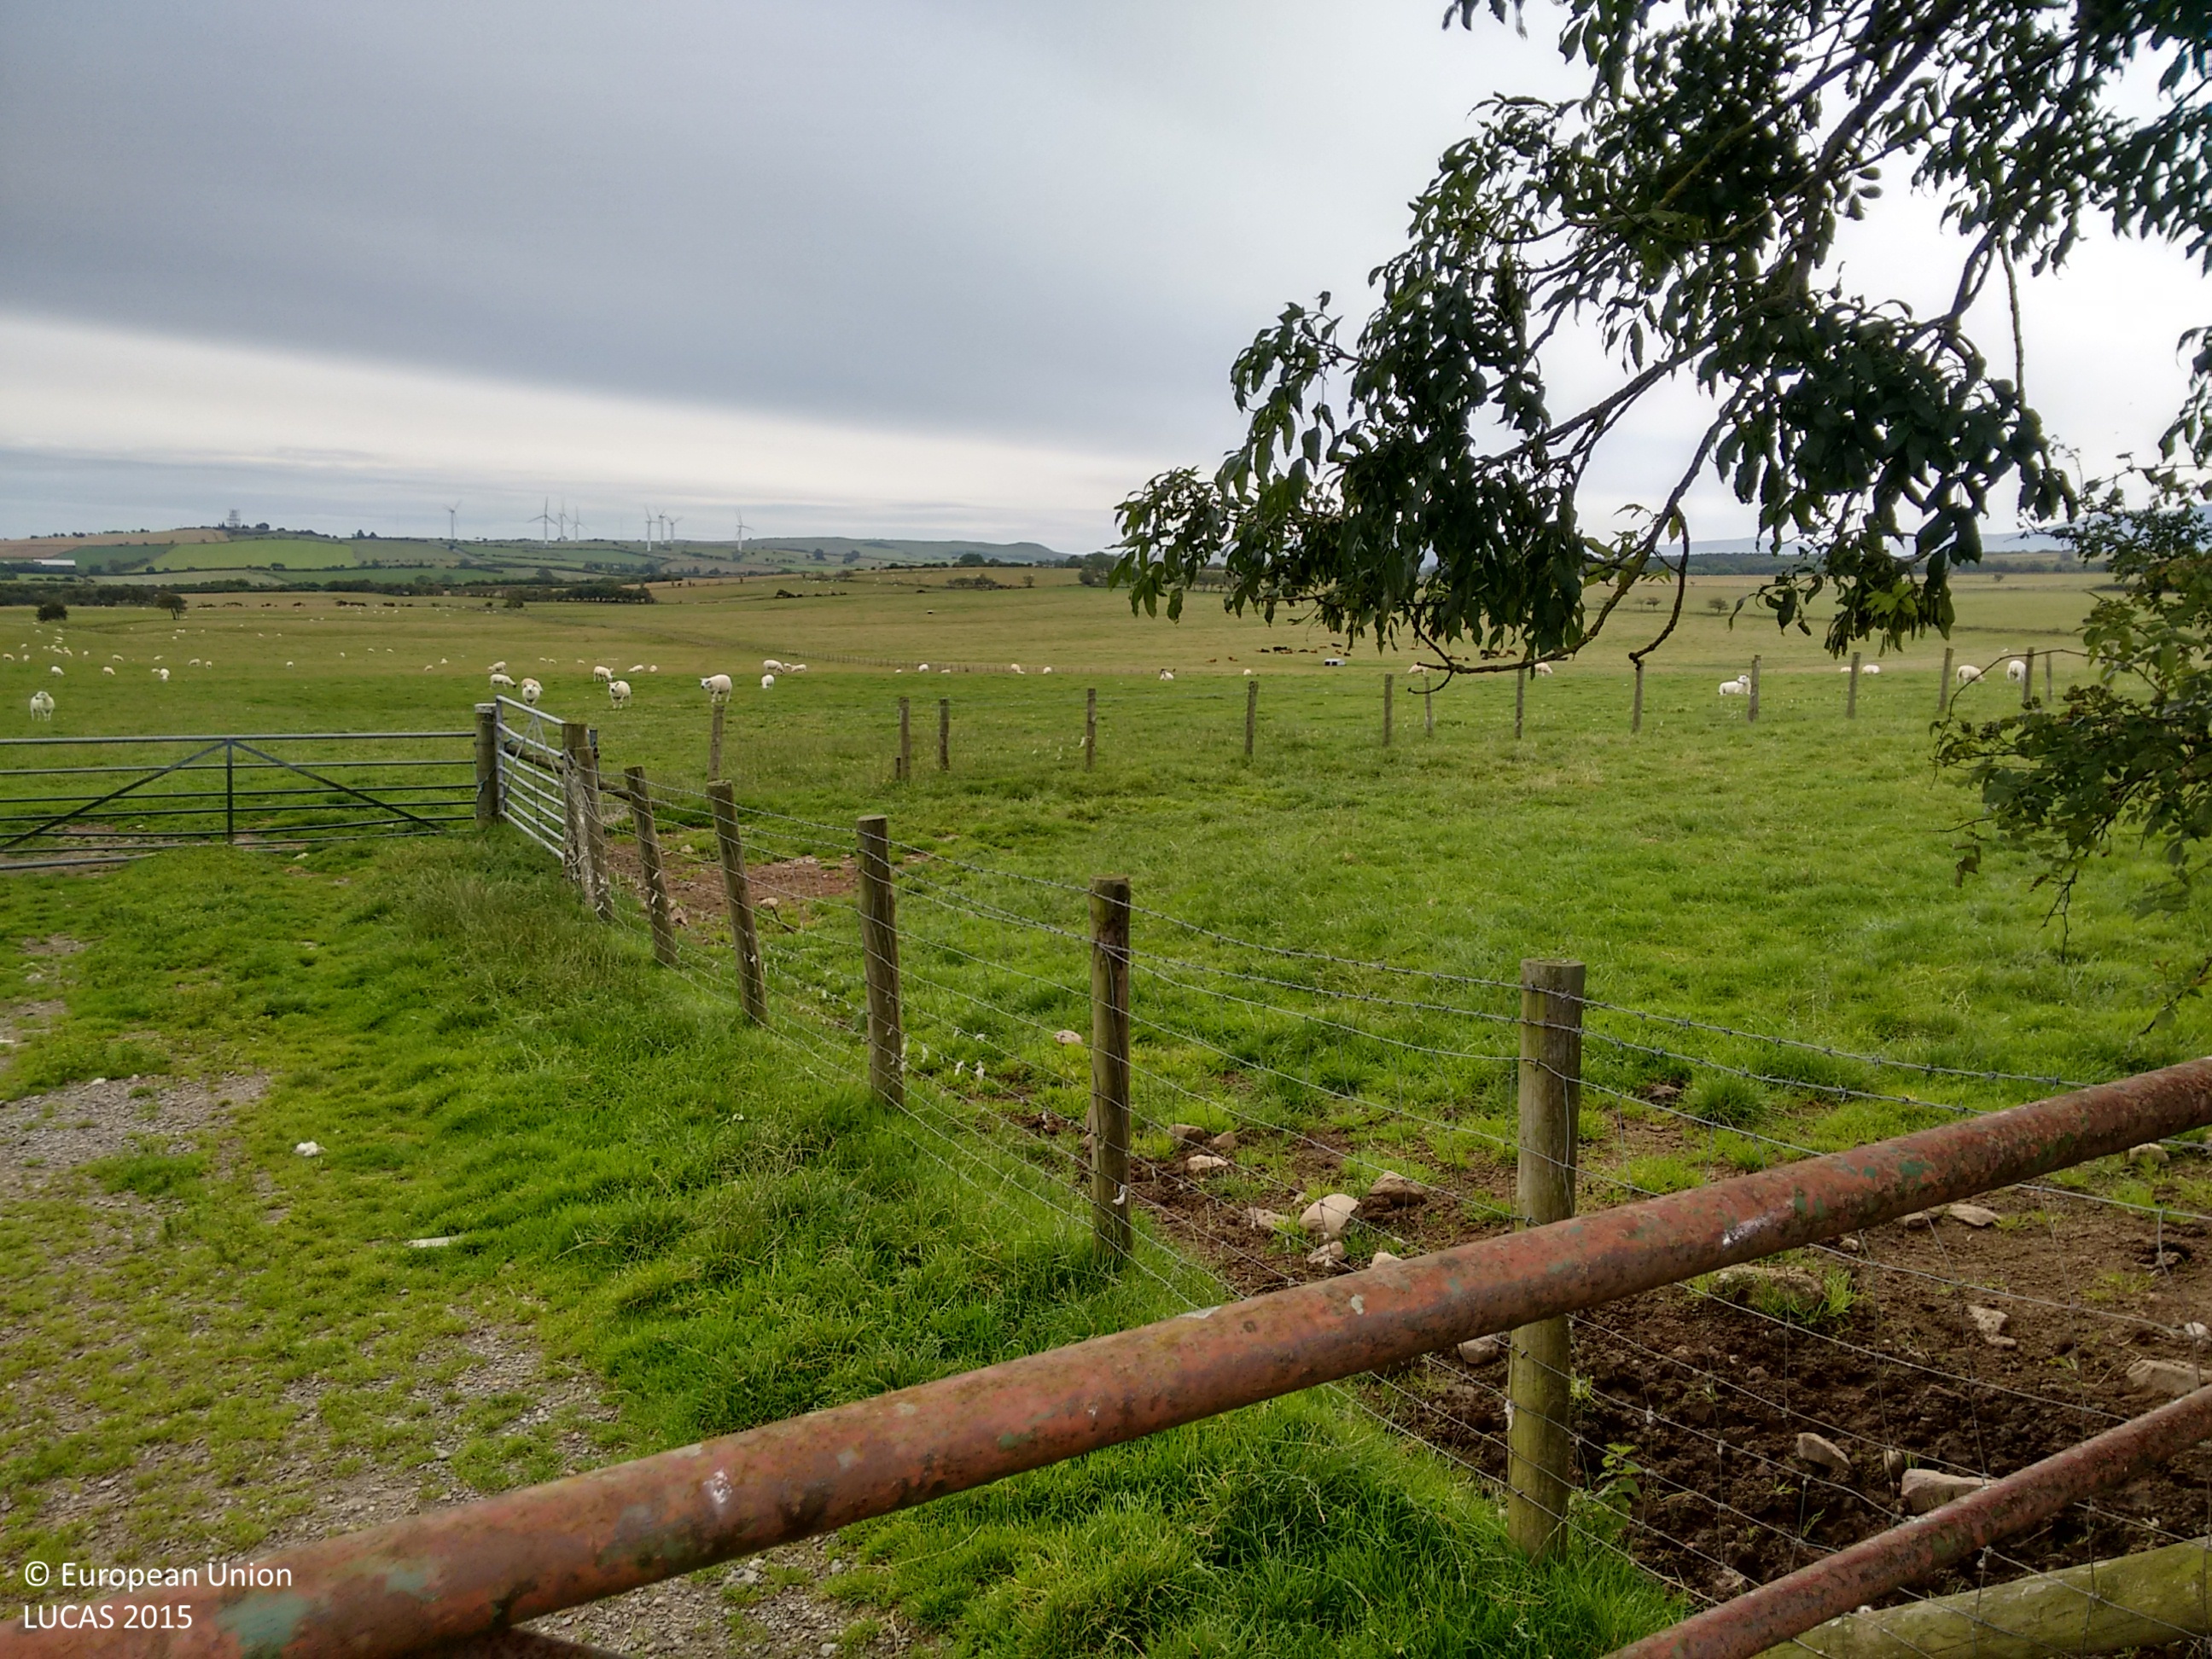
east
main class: Grassland
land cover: Grassland without tree/shrub cover
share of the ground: > 75 %
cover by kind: herbaceous plants 100 %
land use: Agriculture (excluding fallow land and kitchen gardens)
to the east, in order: Grassland without tree/shrub cover; Fences; Grassland without tree/shrub cover
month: August
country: GB
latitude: 54.7226
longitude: -3.3216
